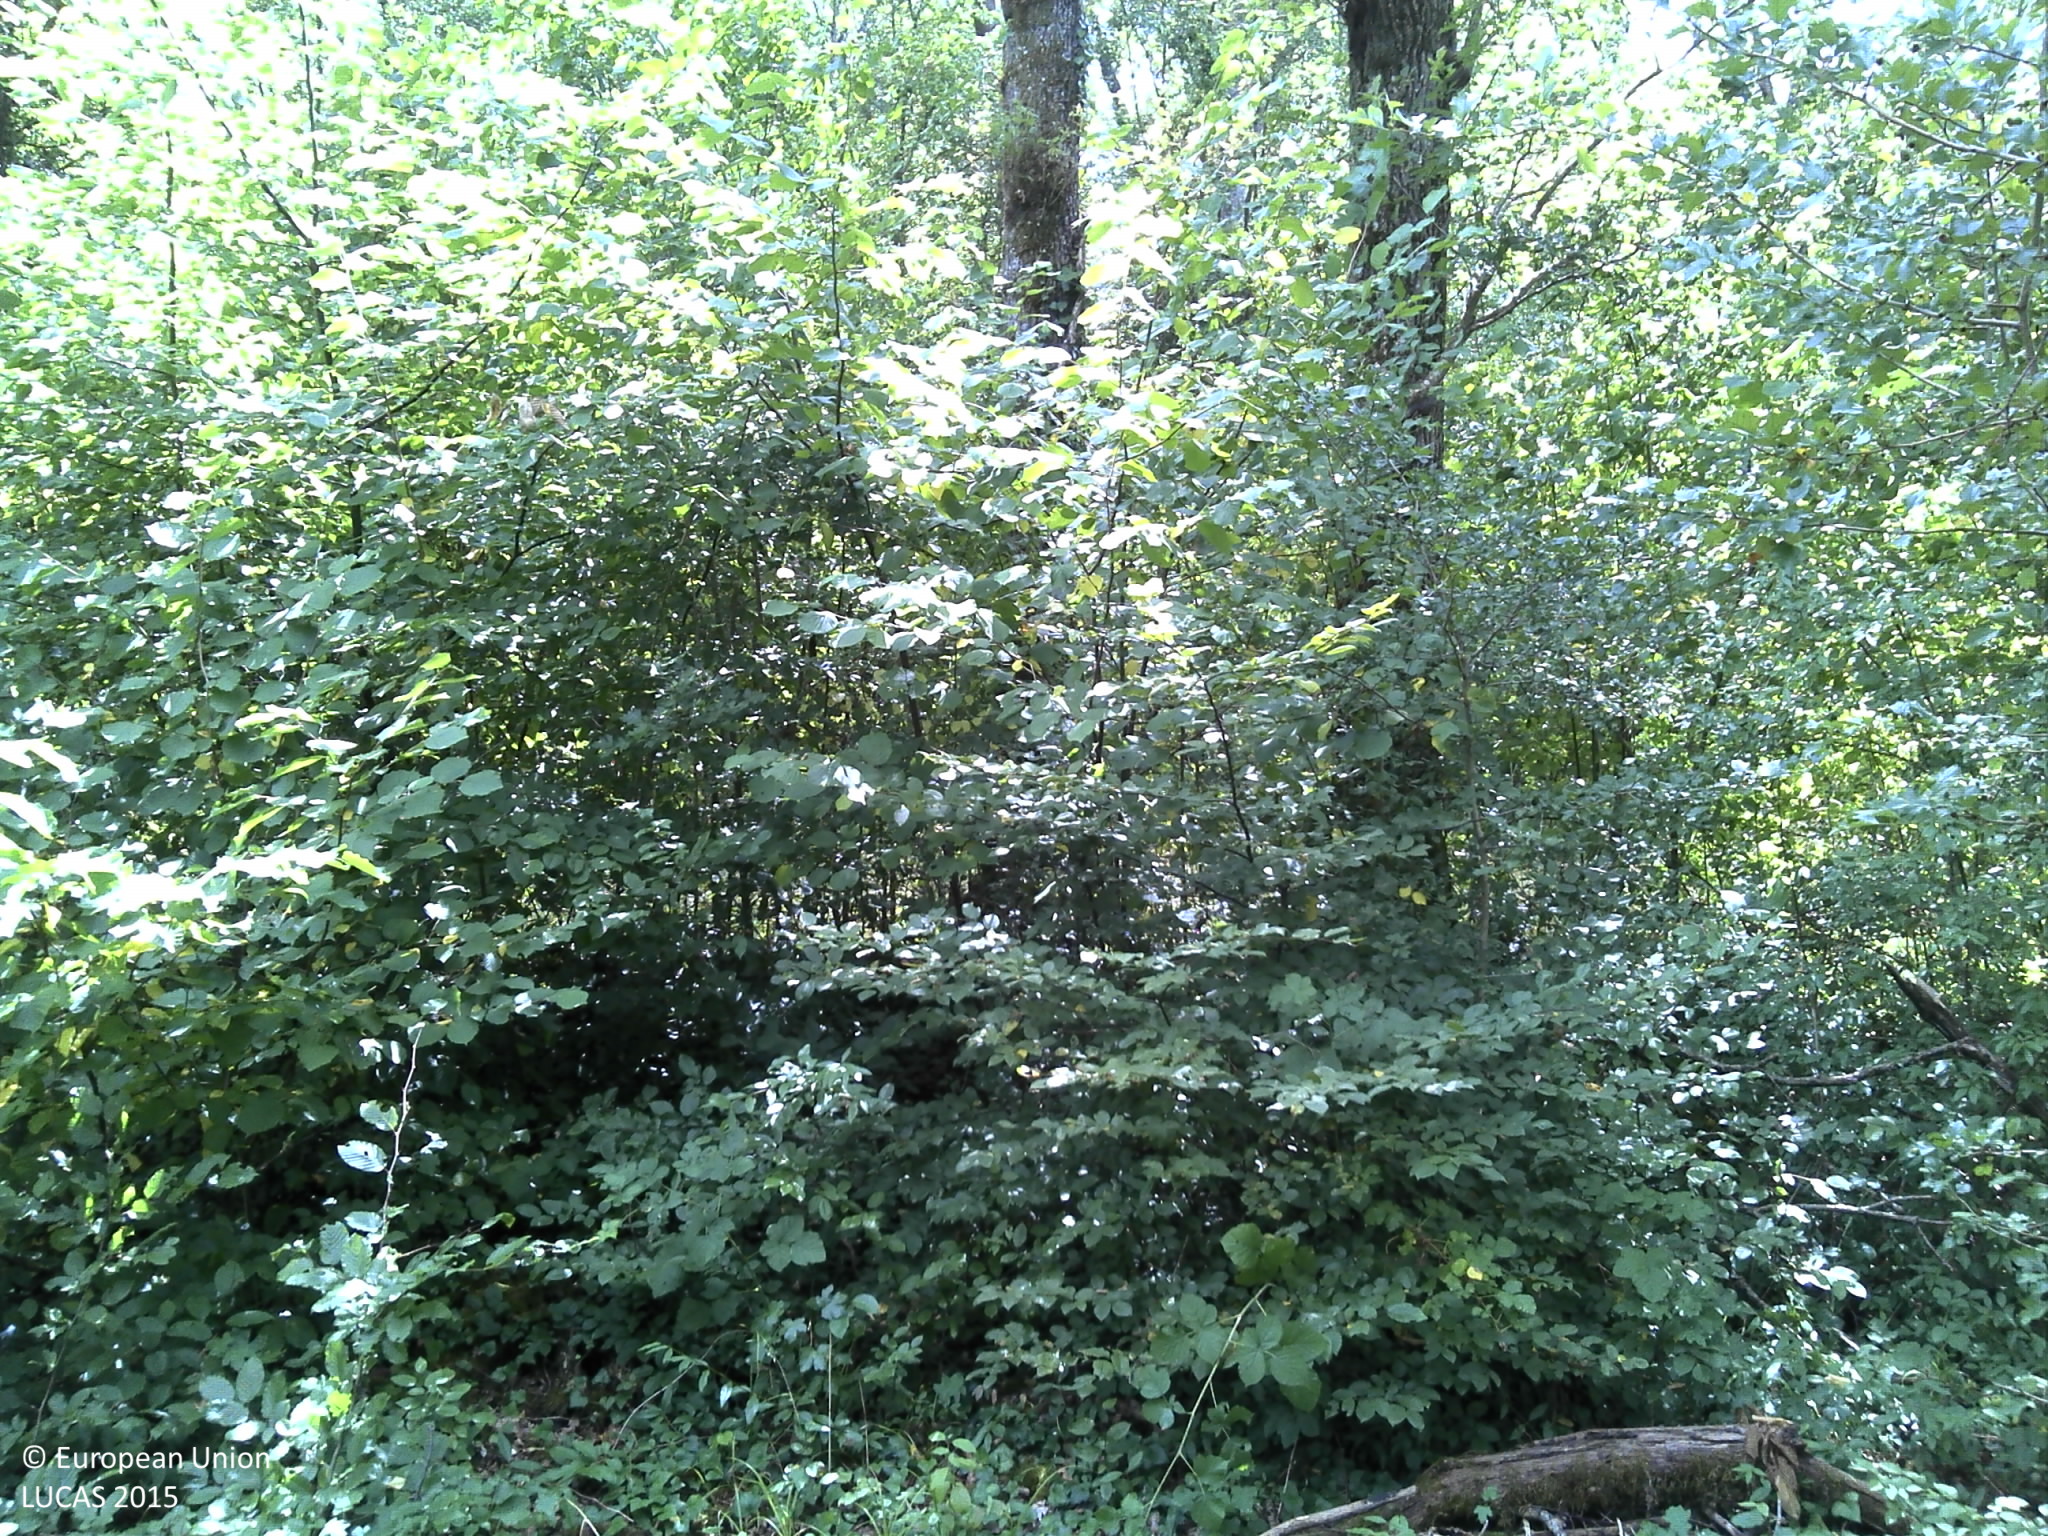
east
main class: Woodland
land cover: Broadleaved woodland
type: beech forest
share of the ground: > 75 %
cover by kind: broadleaved forest trees 85 %, herbaceous plants 10 %, coniferous forest trees 5 %
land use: Forestry
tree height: > 5 m
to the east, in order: Broadleaved woodland; Tracks; Broadleaved woodland
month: July
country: FR
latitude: 48.8007
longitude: 4.7286
